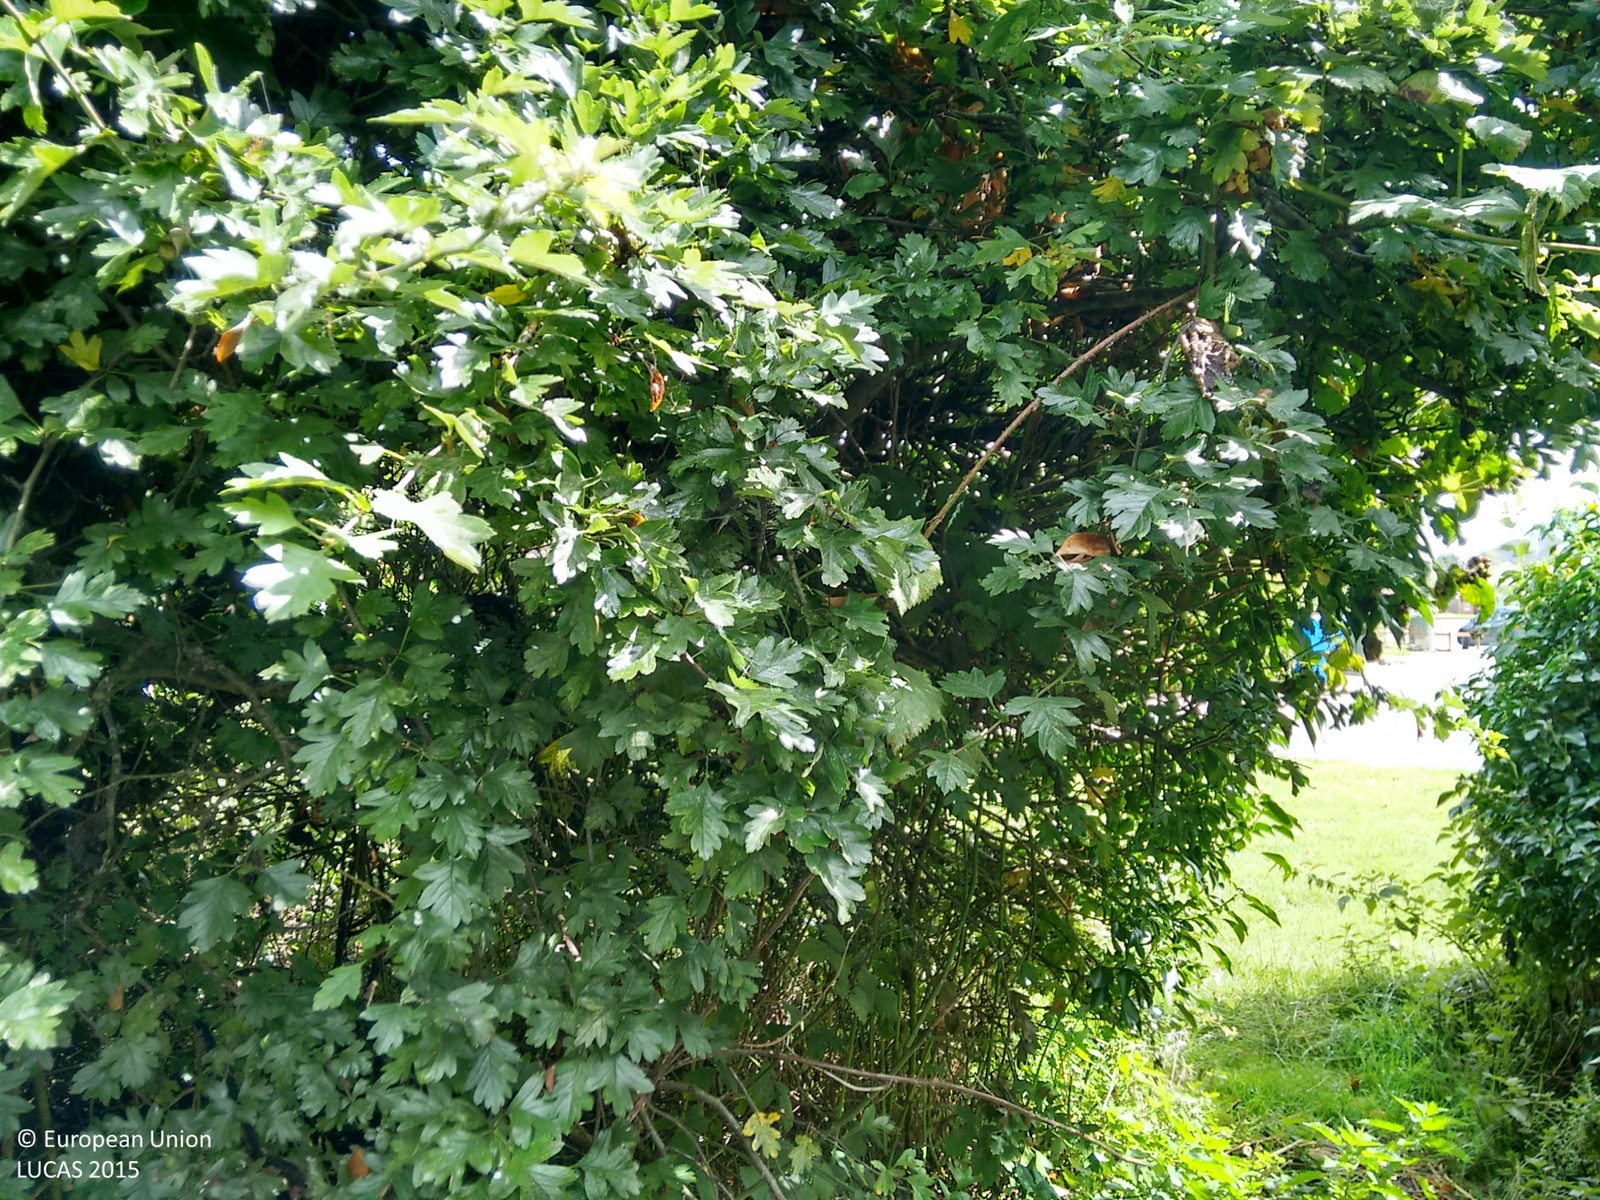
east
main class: Woodland
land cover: Spruce dominated mixed woodland
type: exotic forest
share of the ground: > 75 %
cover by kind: coniferous forest trees 75 %, broadleaved forest trees 25 %
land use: Forestry
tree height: > 5 m
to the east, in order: Spruce dominated mixed woodland; Artificial constructions in urban areas; Grassland with sparse tree/shrub cover
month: August
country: IE
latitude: 52.6432
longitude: -6.2441
